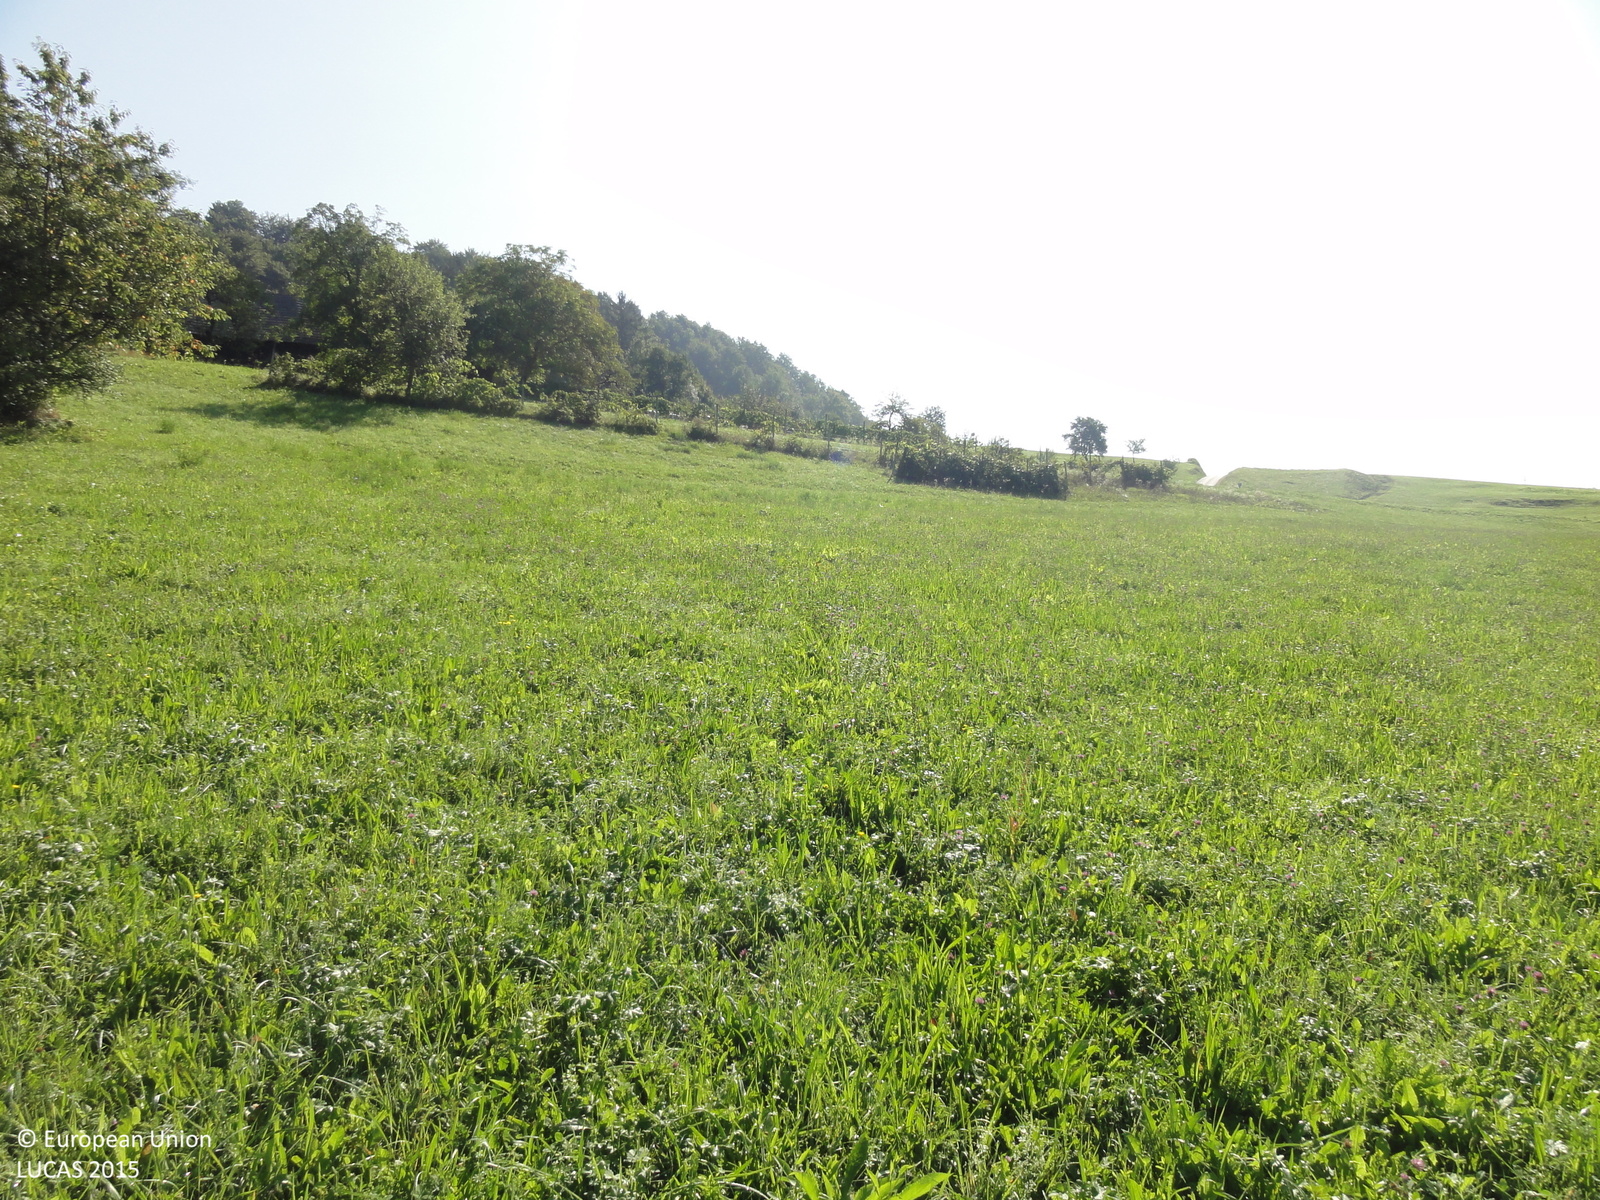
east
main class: Grassland
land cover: Grassland without tree/shrub cover
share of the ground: > 75 %
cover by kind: herbaceous plants 100 %
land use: Agriculture (excluding fallow land and kitchen gardens)
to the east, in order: Grassland without tree/shrub cover; Grassland with sparse tree/shrub cover; Fences; Managed hedges; Grassland without tree/shrub cover; Fences; Managed hedges; Nuts trees; Artificial constructions in urban areas; Grassland without tree/shrub cover; Paved roads, cycling and walking lanes; Grassland without tree/shrub cover; Other fresh vegetables; Dry pulses; Potatoes; Lucerne; Apple fruit; Tracks; Grassland with sparse tree/shrub cover; Broadleaved woodland; Spruce dominated mixed woodland; Broadleaved woodland; Grassland with sparse tree/shrub cover
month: August
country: SI
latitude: 46.1146
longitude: 15.2377
